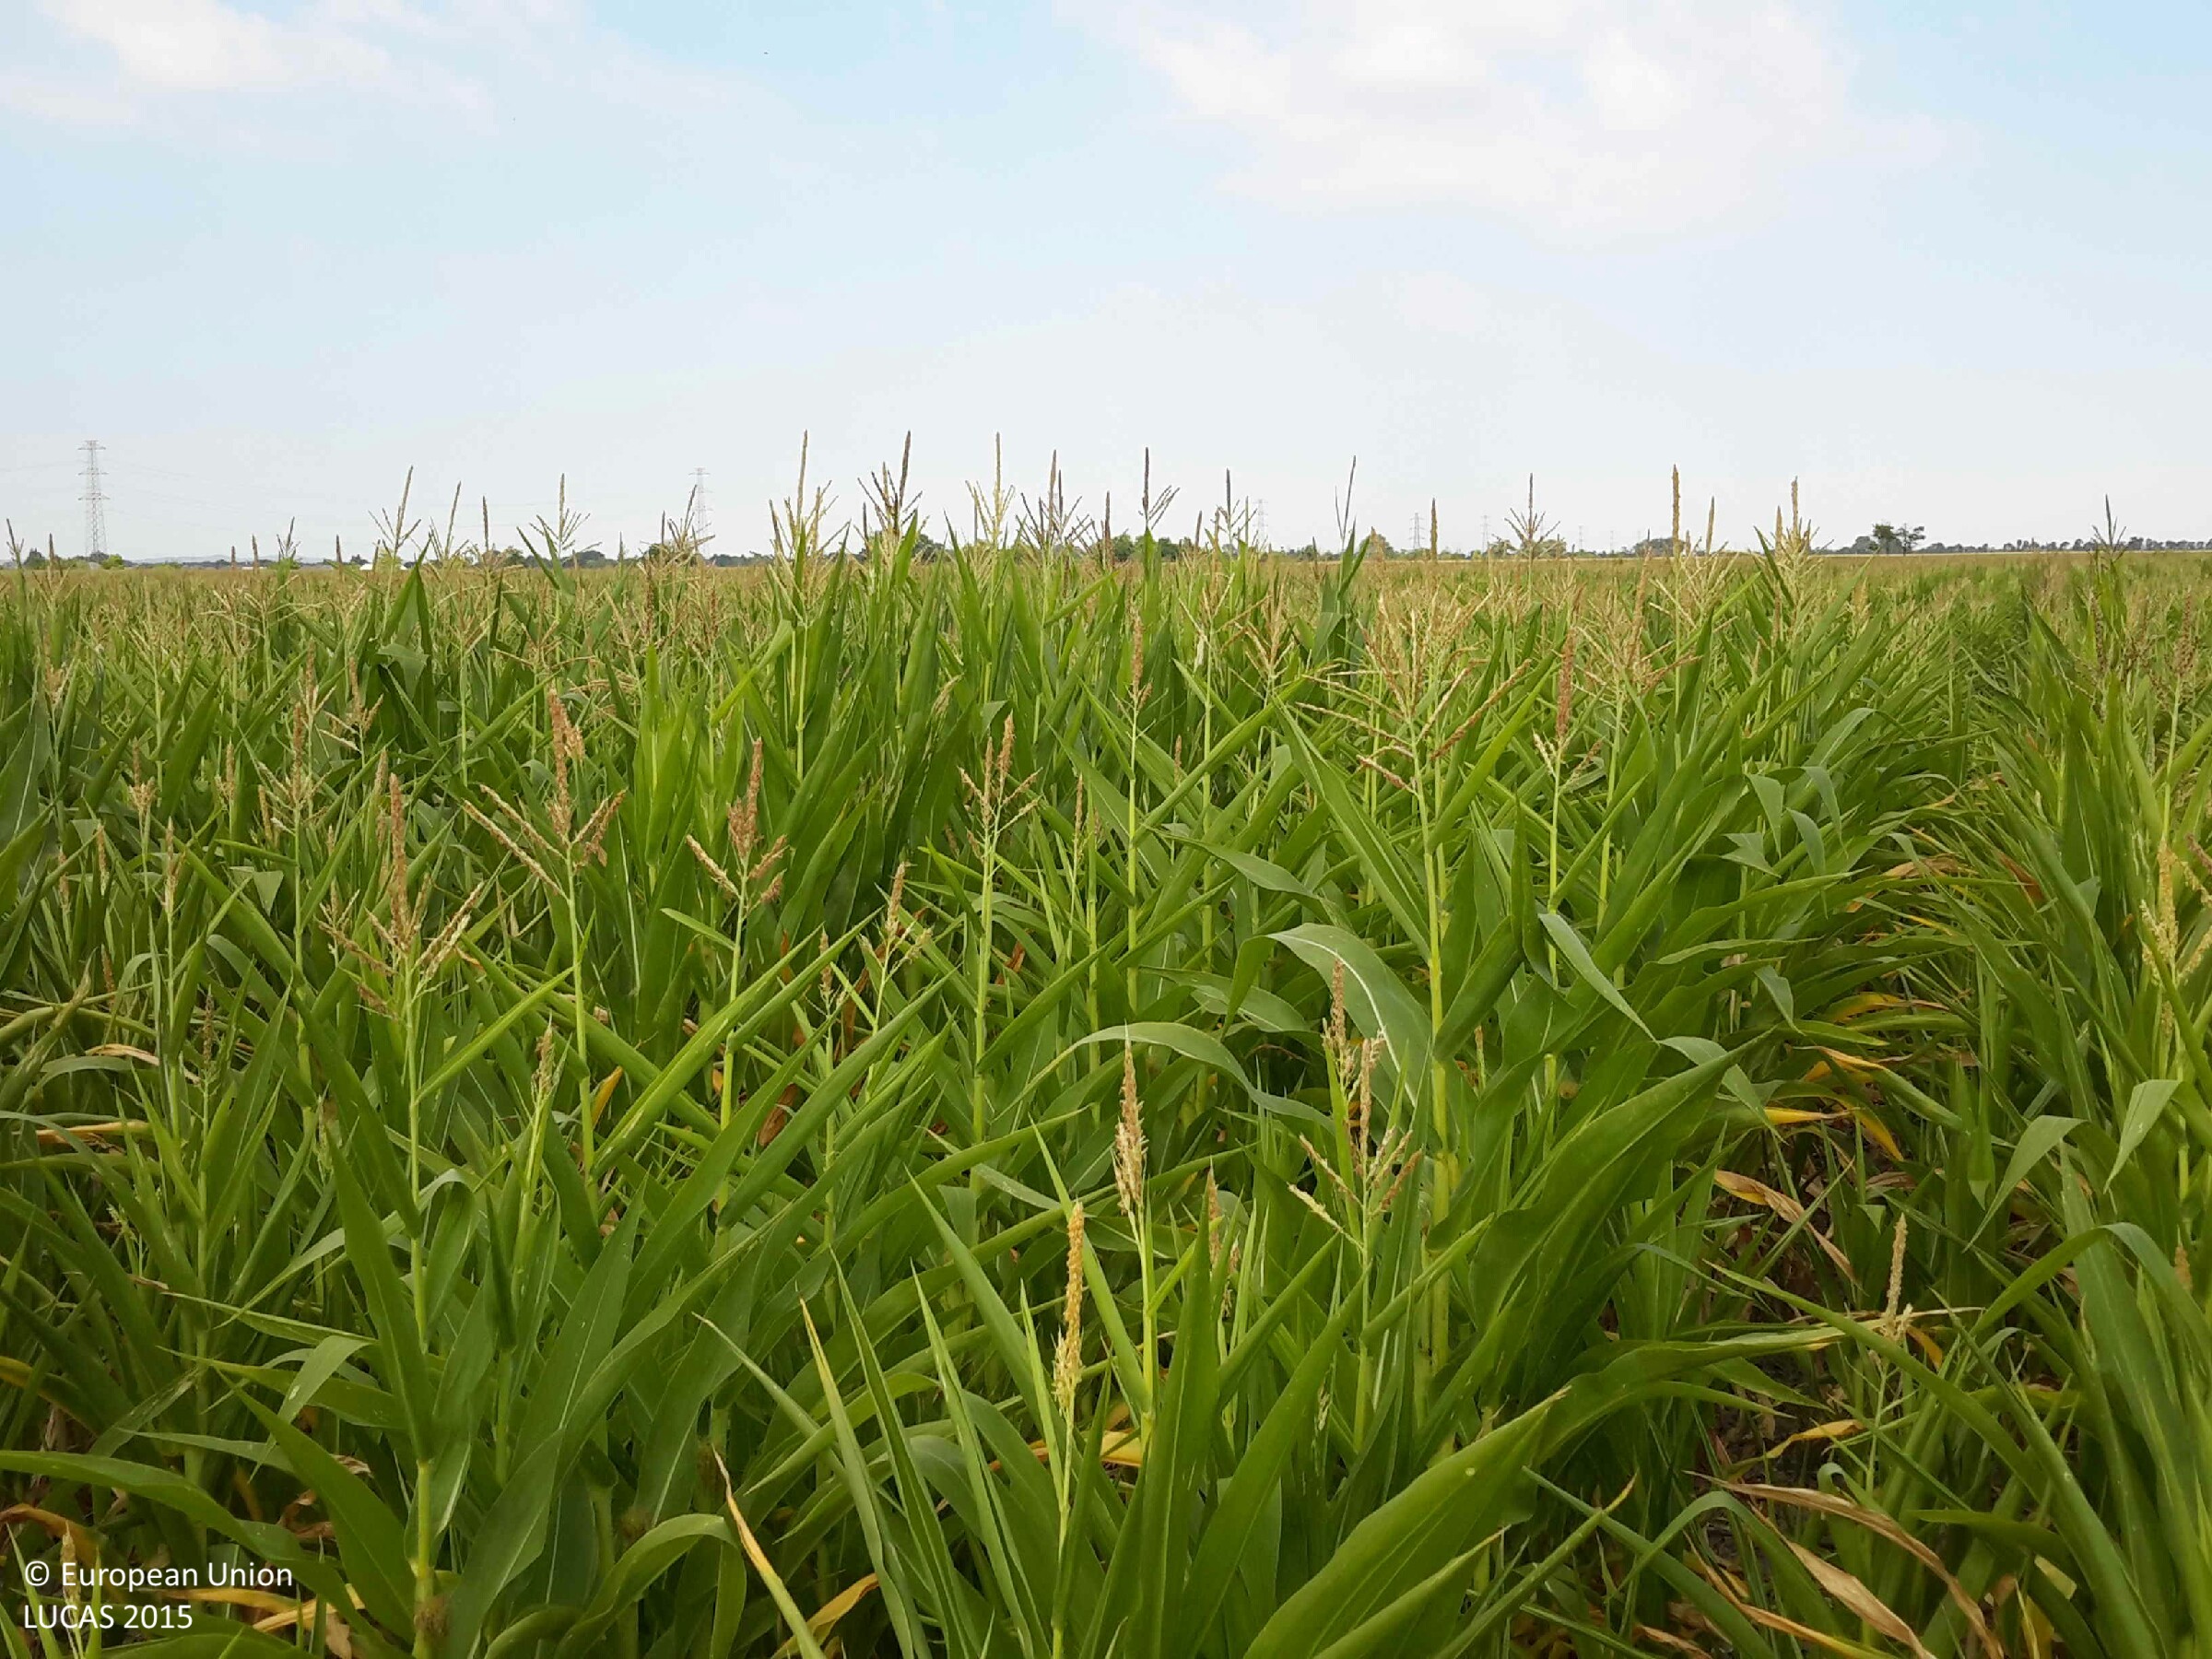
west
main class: Cropland
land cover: Maize
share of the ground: > 75 %
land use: Agriculture (excluding fallow land and kitchen gardens)
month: July
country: HU
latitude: 47.6124
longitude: 17.9263
